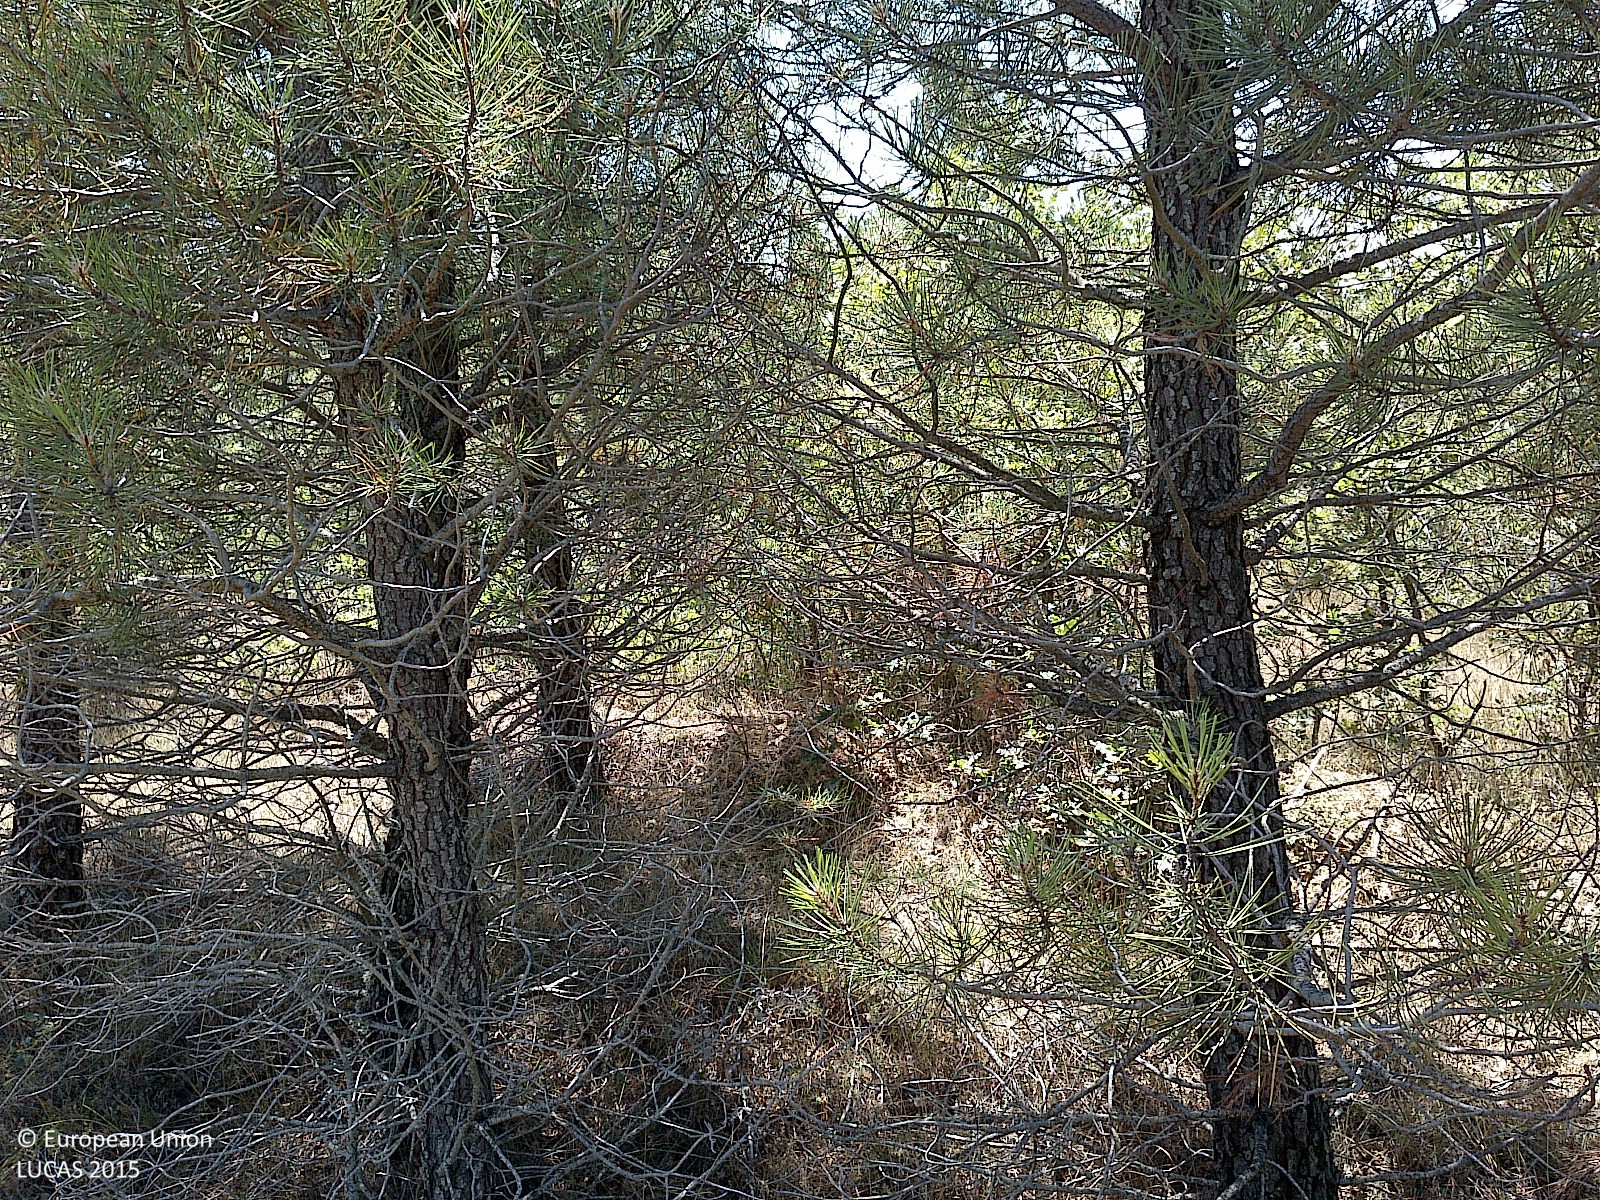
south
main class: Woodland
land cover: Pine dominated mixed woodland
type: coniferous forest of the mediterranean region
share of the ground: 50 - 75 %
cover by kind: coniferous forest trees 50 %, herbaceous plants 25 %, broadleaved forest trees 20 %, unconsolidated bare surface 5 %
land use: Forestry
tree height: < 5 m
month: July
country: ES
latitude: 41.6963
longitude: -2.0364
